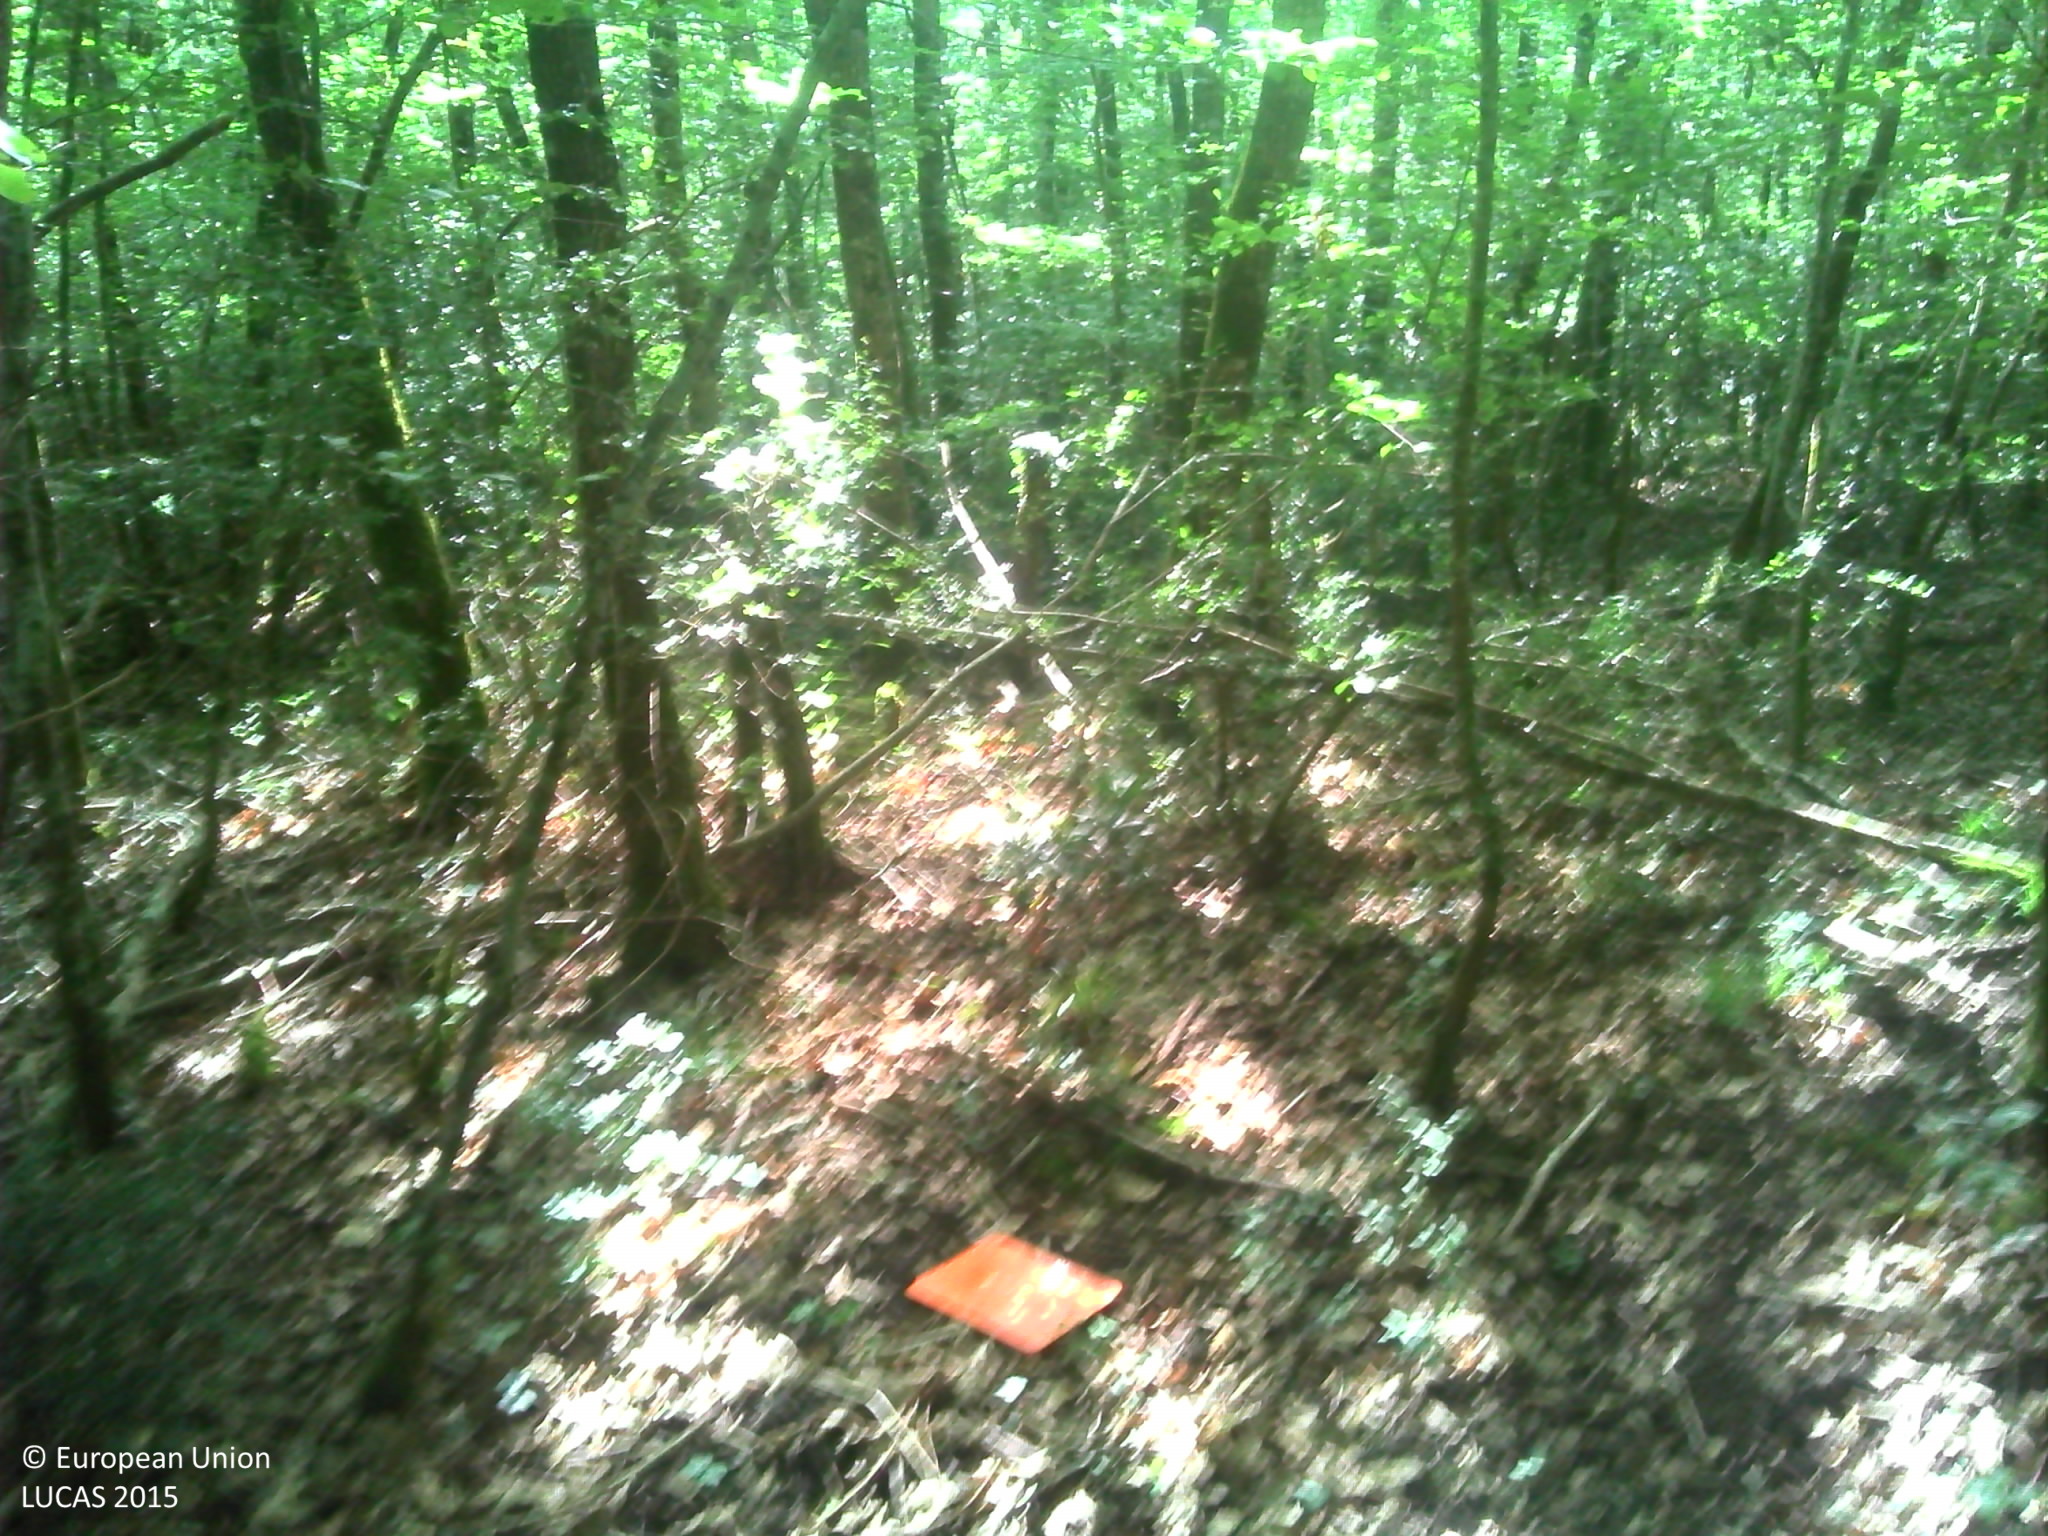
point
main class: Woodland
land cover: Broadleaved woodland
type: mesophytic deciduous forest
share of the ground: > 75 %
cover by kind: unconsolidated bare surface 50 %, herbaceous plants 30 %, broadleaved forest trees 20 %
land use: Forestry
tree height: > 5 m
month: June
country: FR
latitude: 47.5224
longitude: 1.3659
